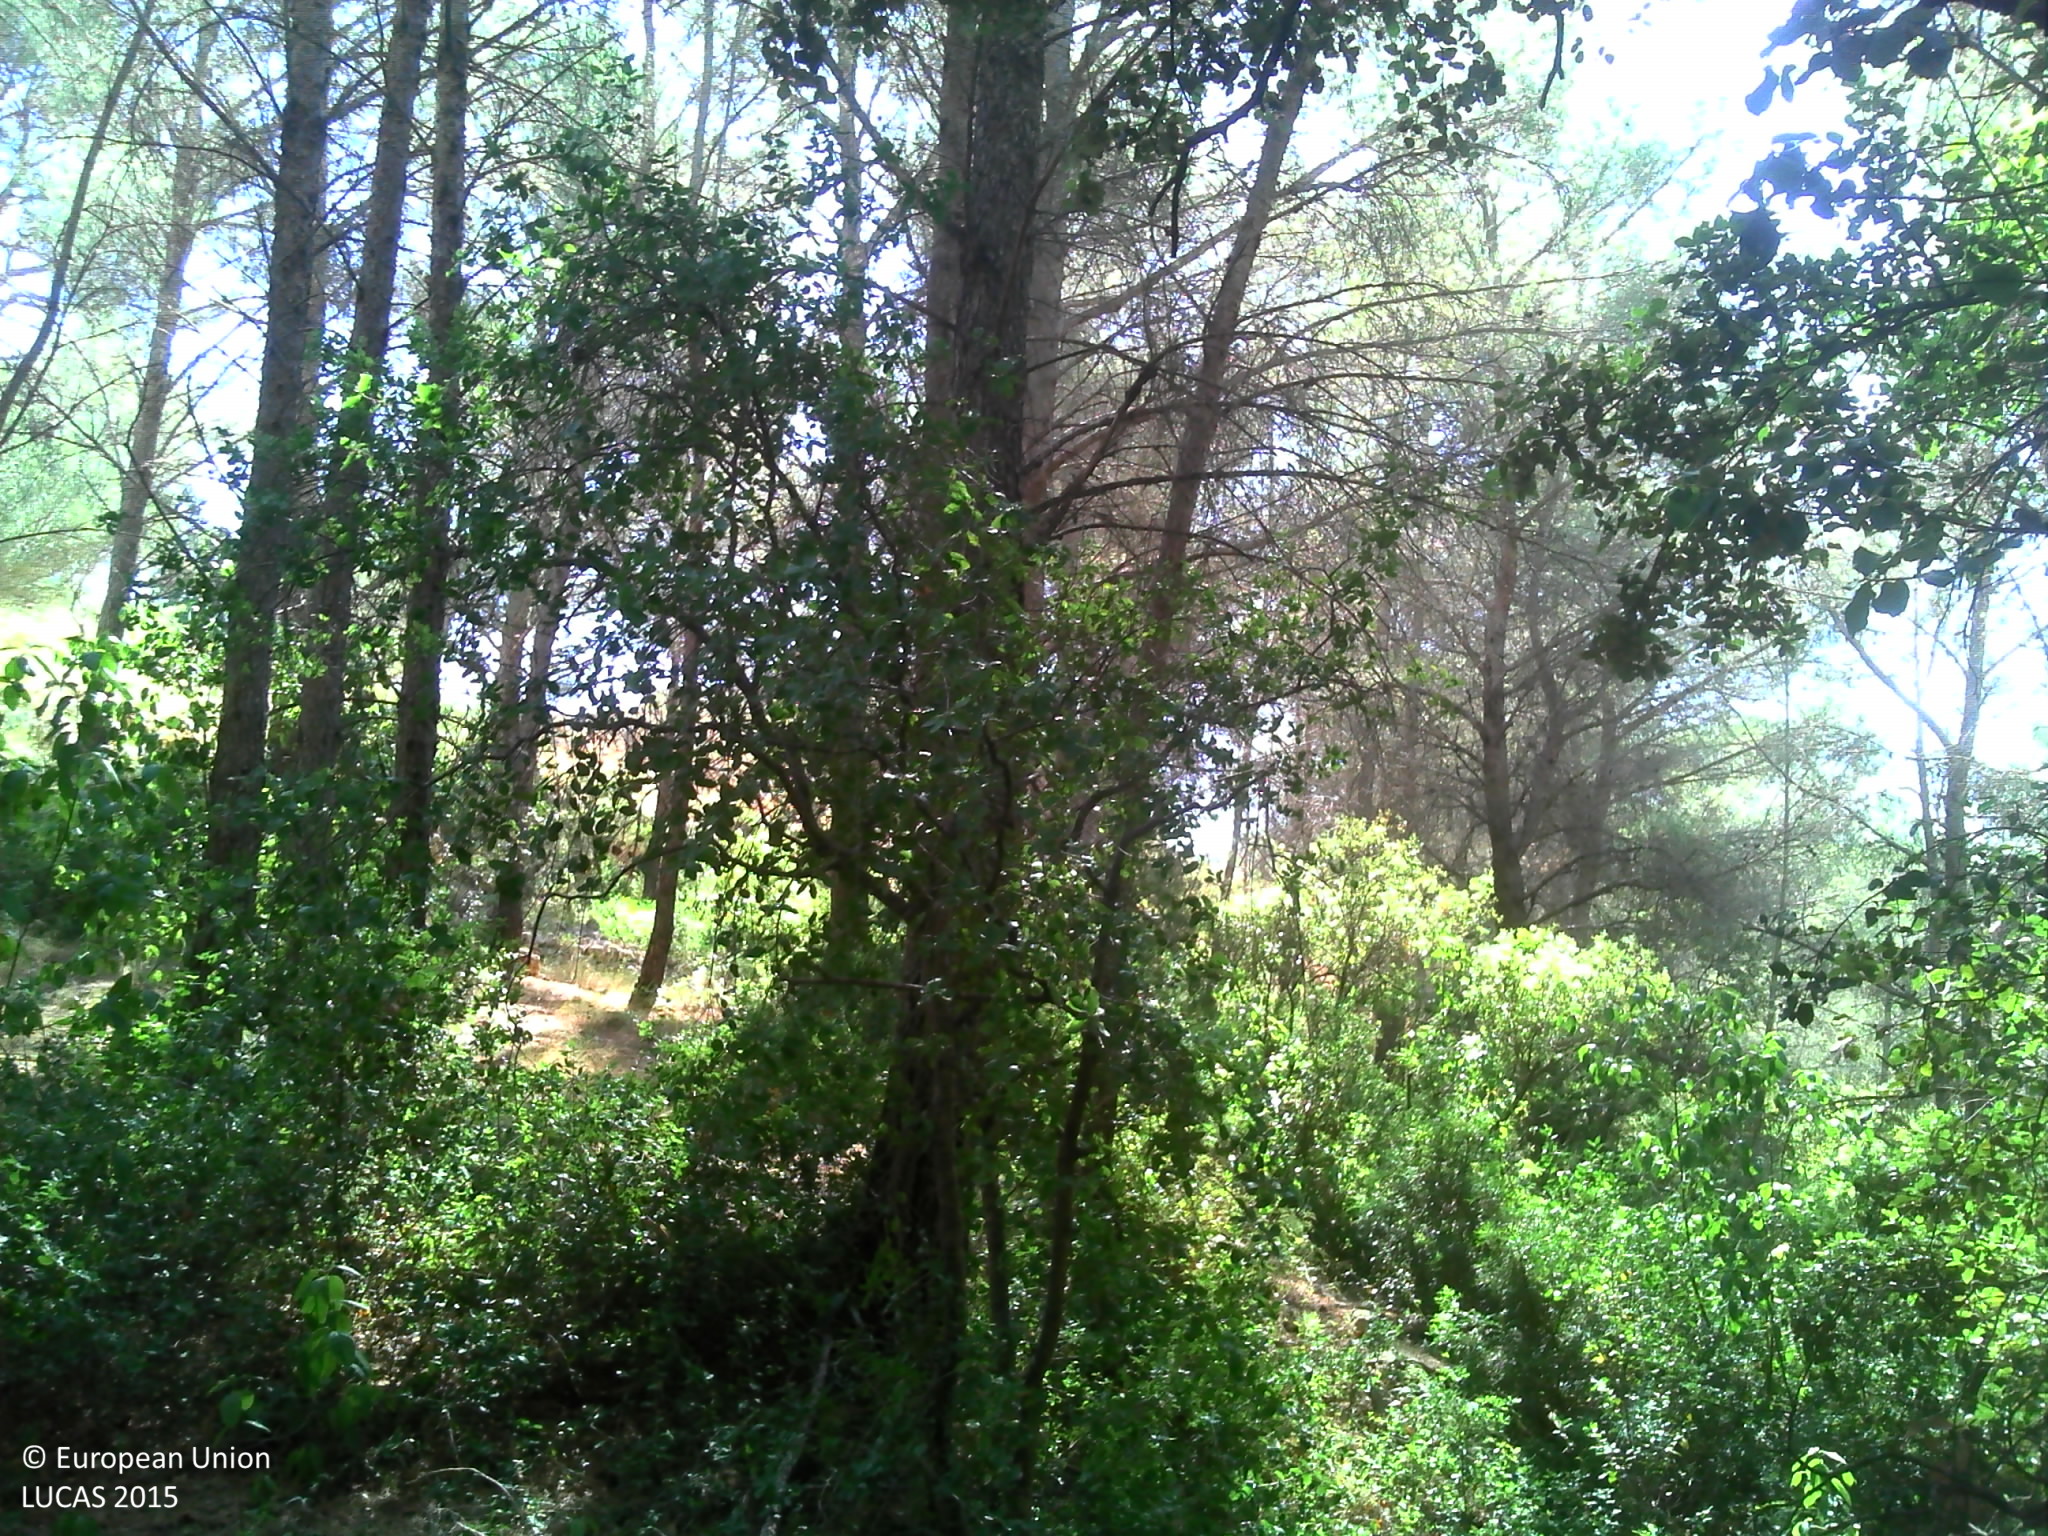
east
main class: Woodland
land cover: Pine dominated coniferous woodland
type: coniferous forest of the mediterranean region
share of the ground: > 75 %
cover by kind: coniferous forest trees 90 %, consolidated bare surface 10 %
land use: Residential
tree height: > 5 m
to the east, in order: Pine dominated coniferous woodland; Dry stone walls; Shrubland with sparse tree cover; Dry stone walls; Shrubland with sparse tree cover; Dry stone walls; Shrubland with sparse tree cover; Dry stone walls; Shrubland with sparse tree cover; Vineyards; Dry stone walls; Vineyards; Dry stone walls; Vineyards; Dry stone walls; Vineyards; Lines of trees; Electric lines; Paved roads, cycling and walking lanes; Spontaneously vegetated surfaces
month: July
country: FR
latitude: 43.1611
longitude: 5.7427
